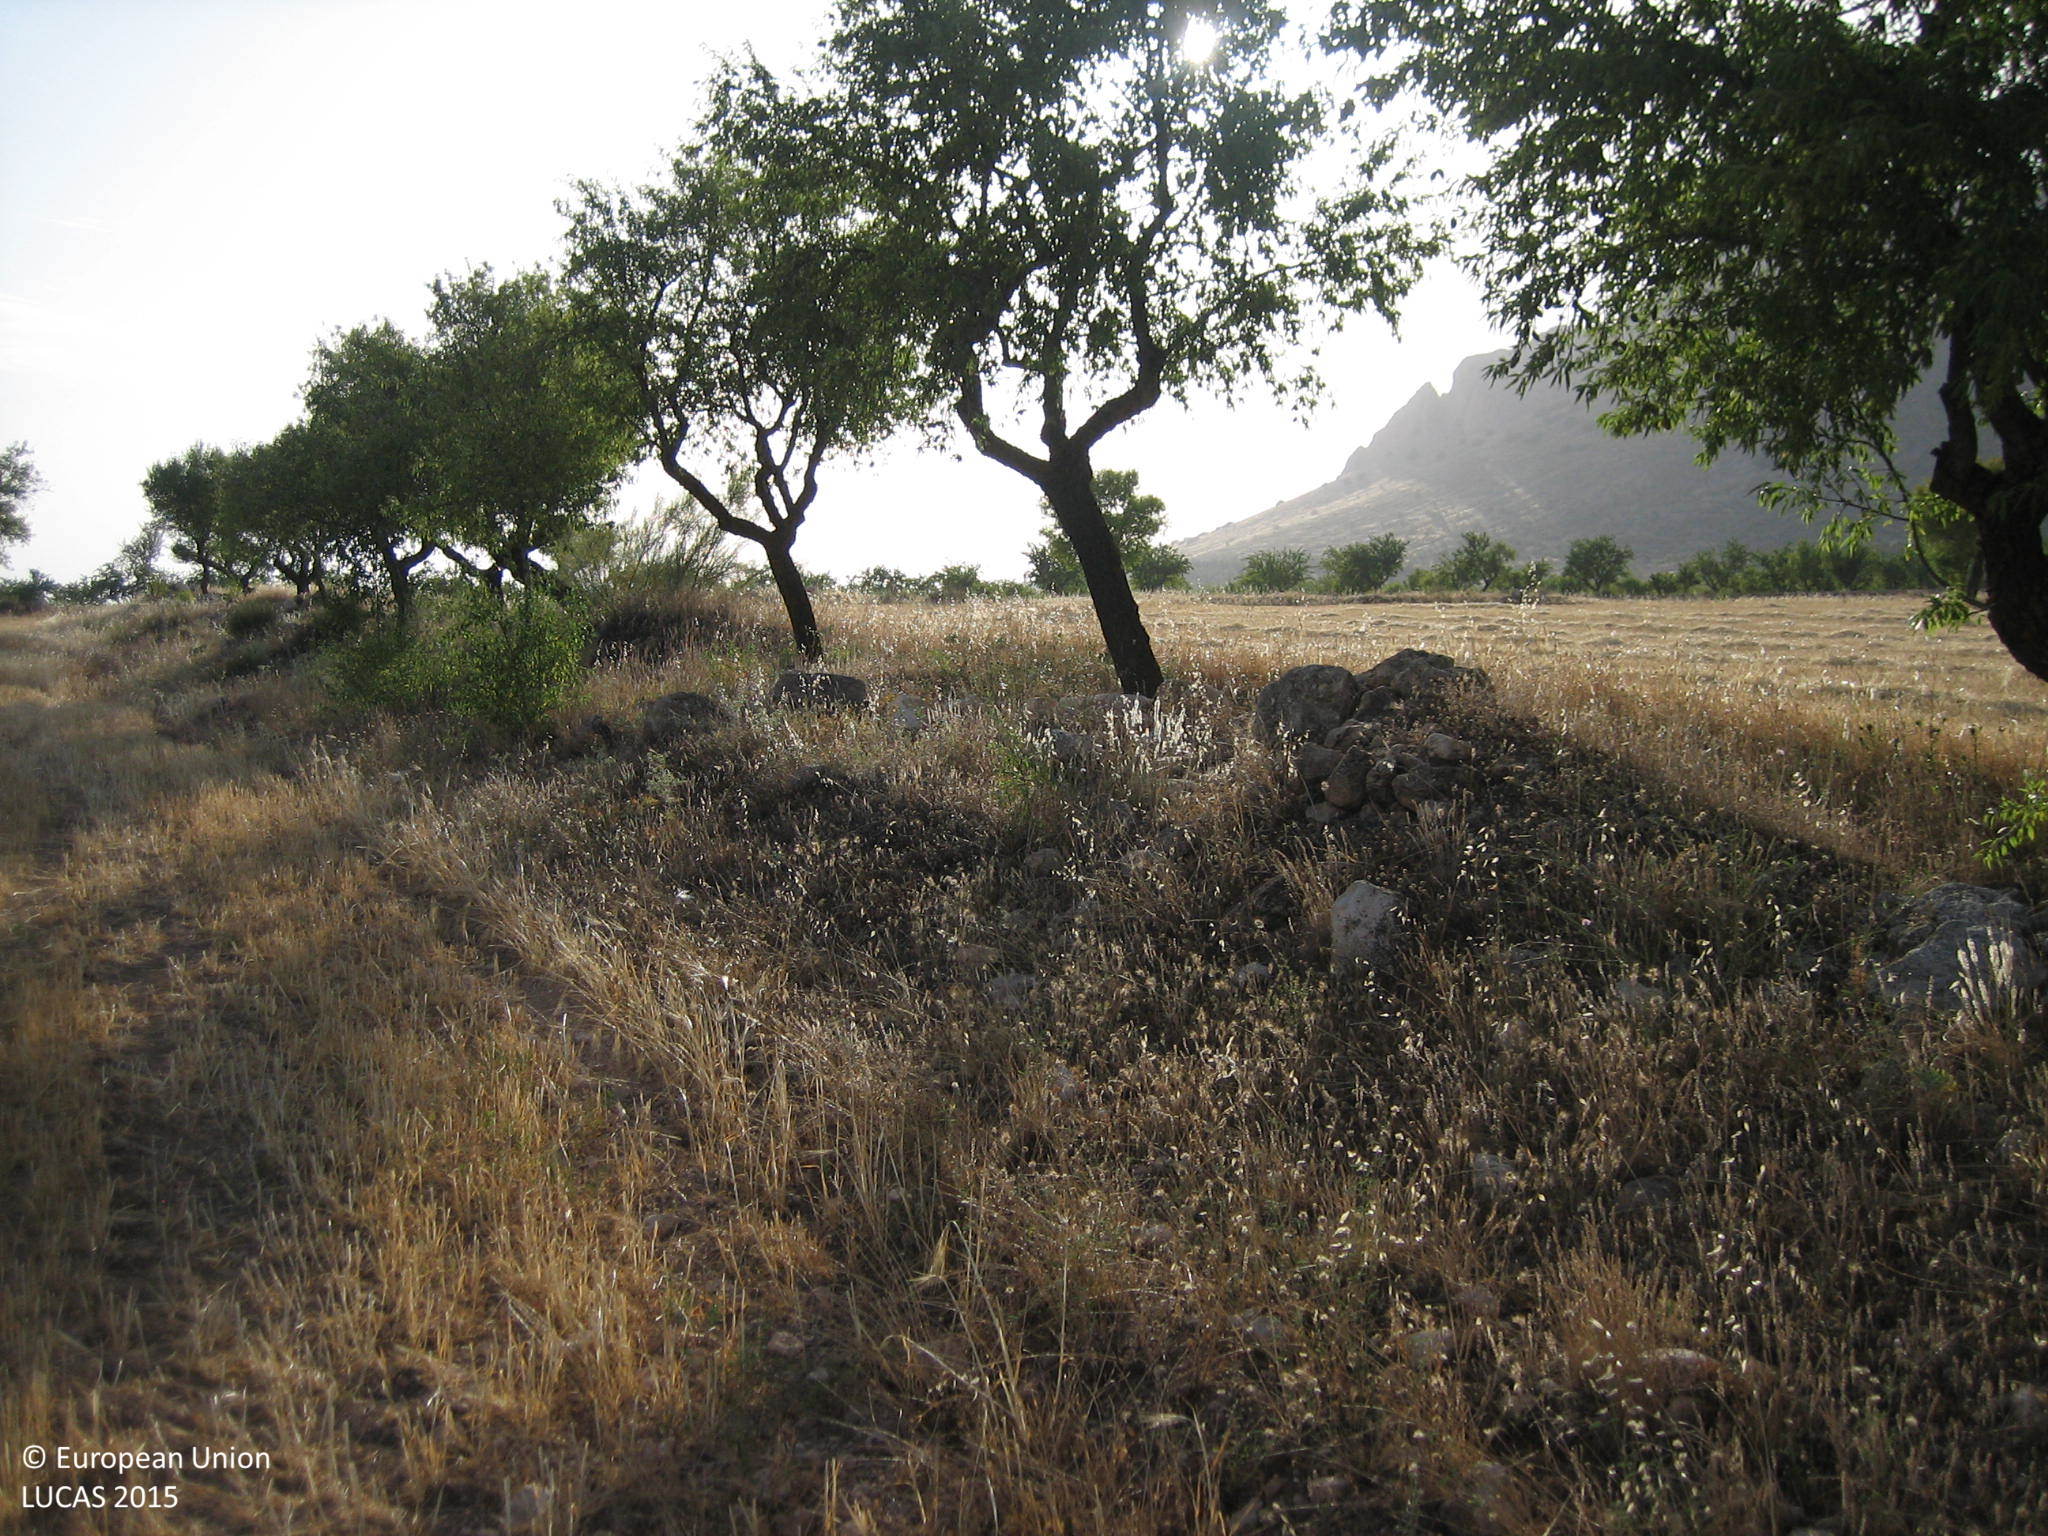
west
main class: Cropland
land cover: Barley
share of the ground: < 10 %
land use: Agriculture (excluding fallow land and kitchen gardens)
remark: Harvested field
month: July
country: ES
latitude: 37.6118
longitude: -2.3907
